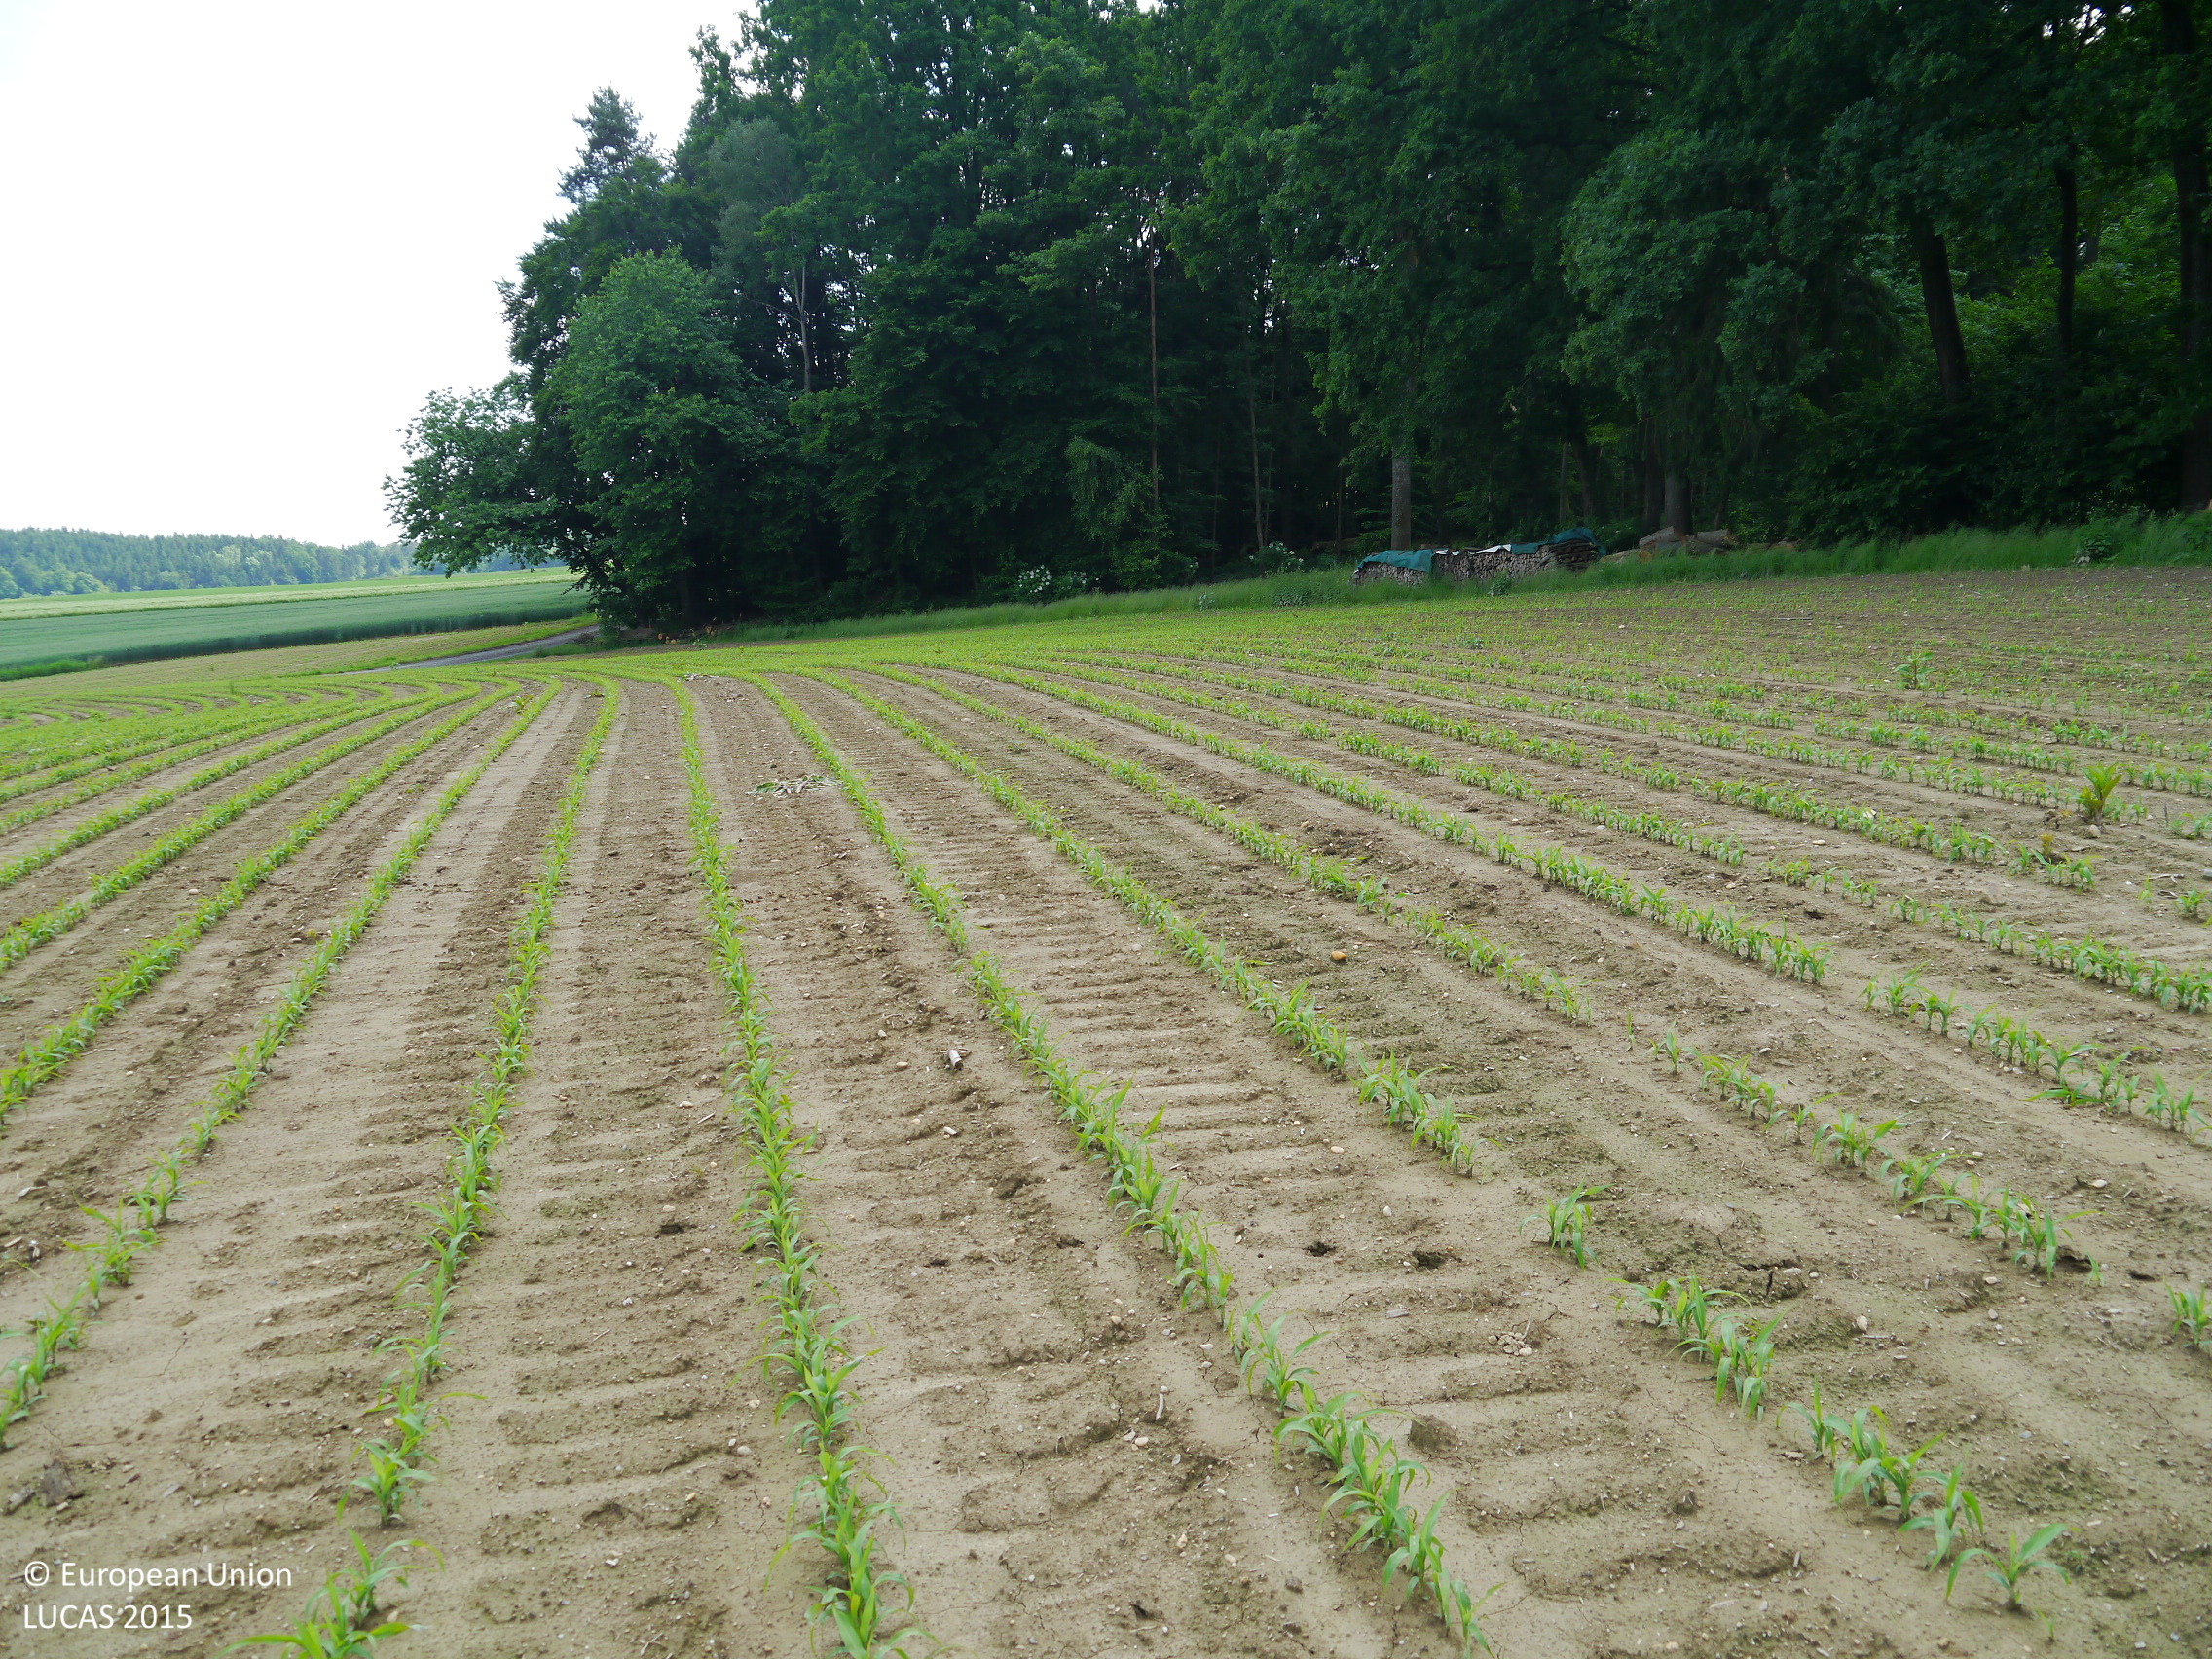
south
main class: Cropland
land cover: Maize
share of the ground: 10 - 25 %
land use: Agriculture (excluding fallow land and kitchen gardens)
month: June
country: AT
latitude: 46.8889
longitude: 15.6301
